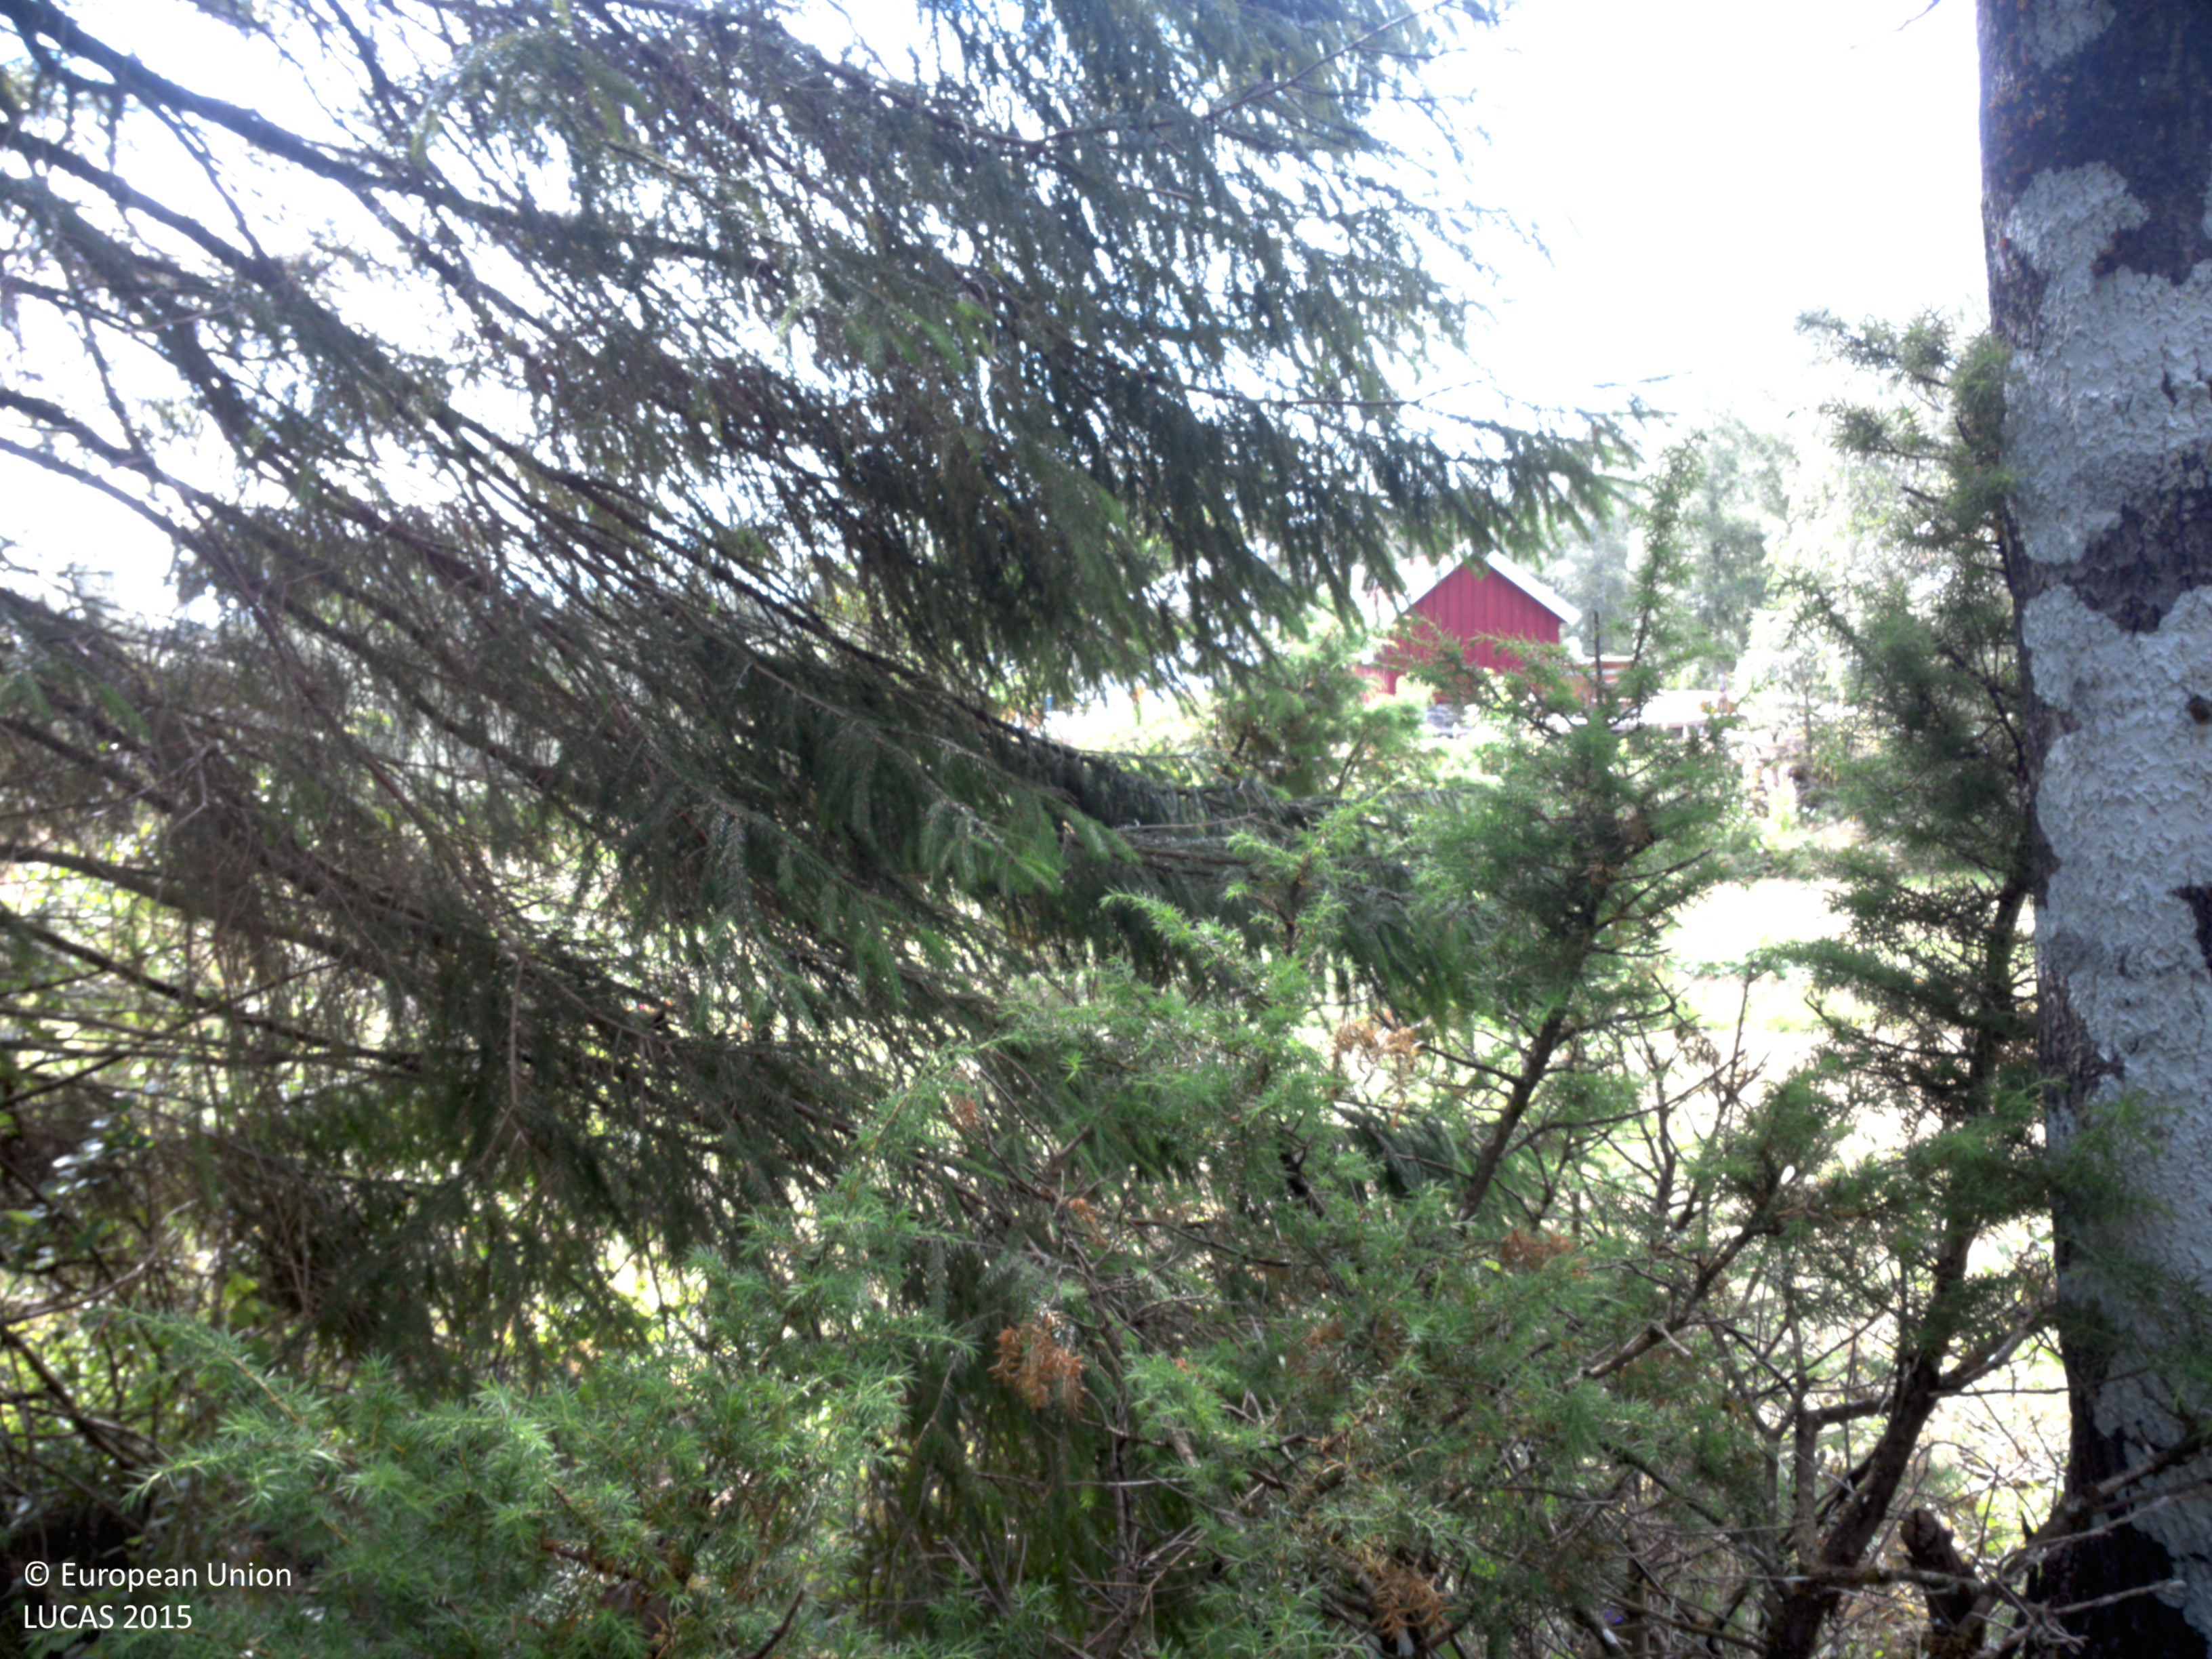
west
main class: Woodland
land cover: Spruce dominated mixed woodland
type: boreal forest
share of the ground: > 75 %
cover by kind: coniferous forest trees 60 %, broadleaved forest trees 20 %, herbaceous plants 10 %, lichens and mosses 10 %
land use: Forestry
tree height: > 5 m
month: July
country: SE
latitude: 58.5663
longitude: 11.8699
